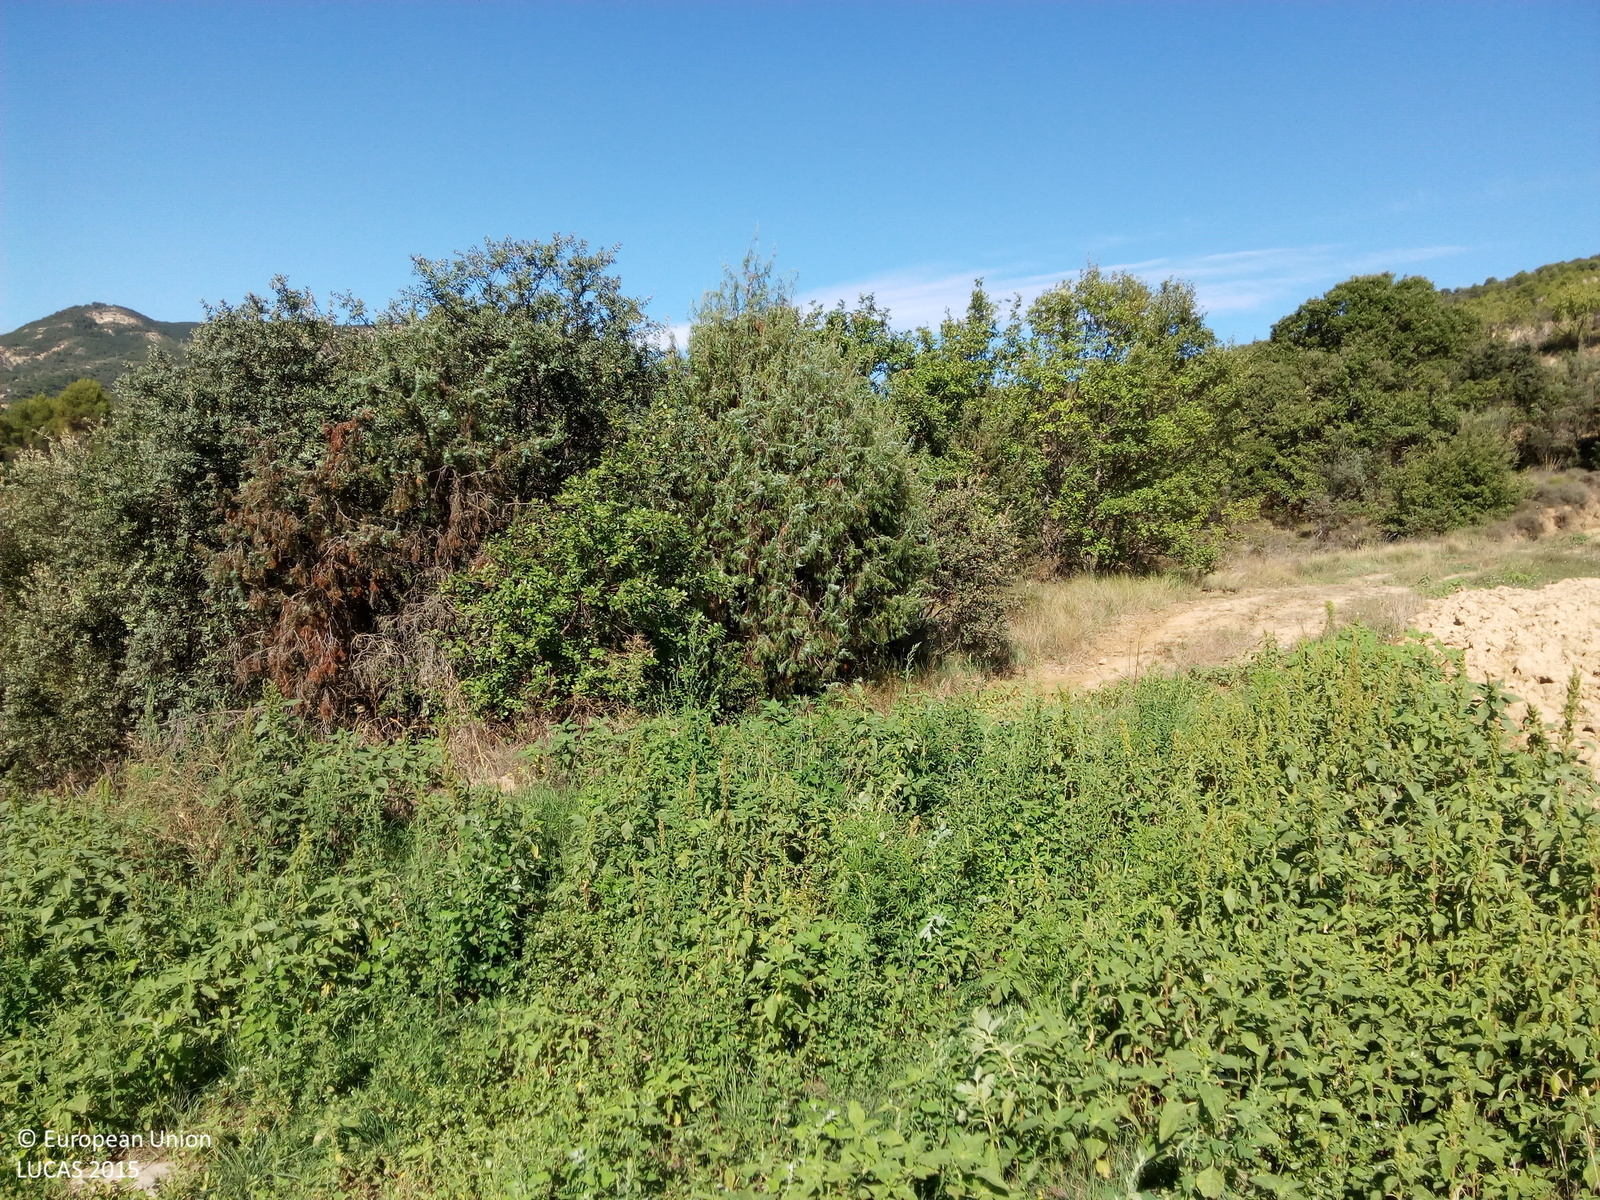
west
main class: Grassland
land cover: Grassland without tree/shrub cover
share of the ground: > 75 %
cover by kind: herbaceous plants 100 %
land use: Semi-natural and natural areas not in use
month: August
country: ES
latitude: 42.2441
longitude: 0.3222
